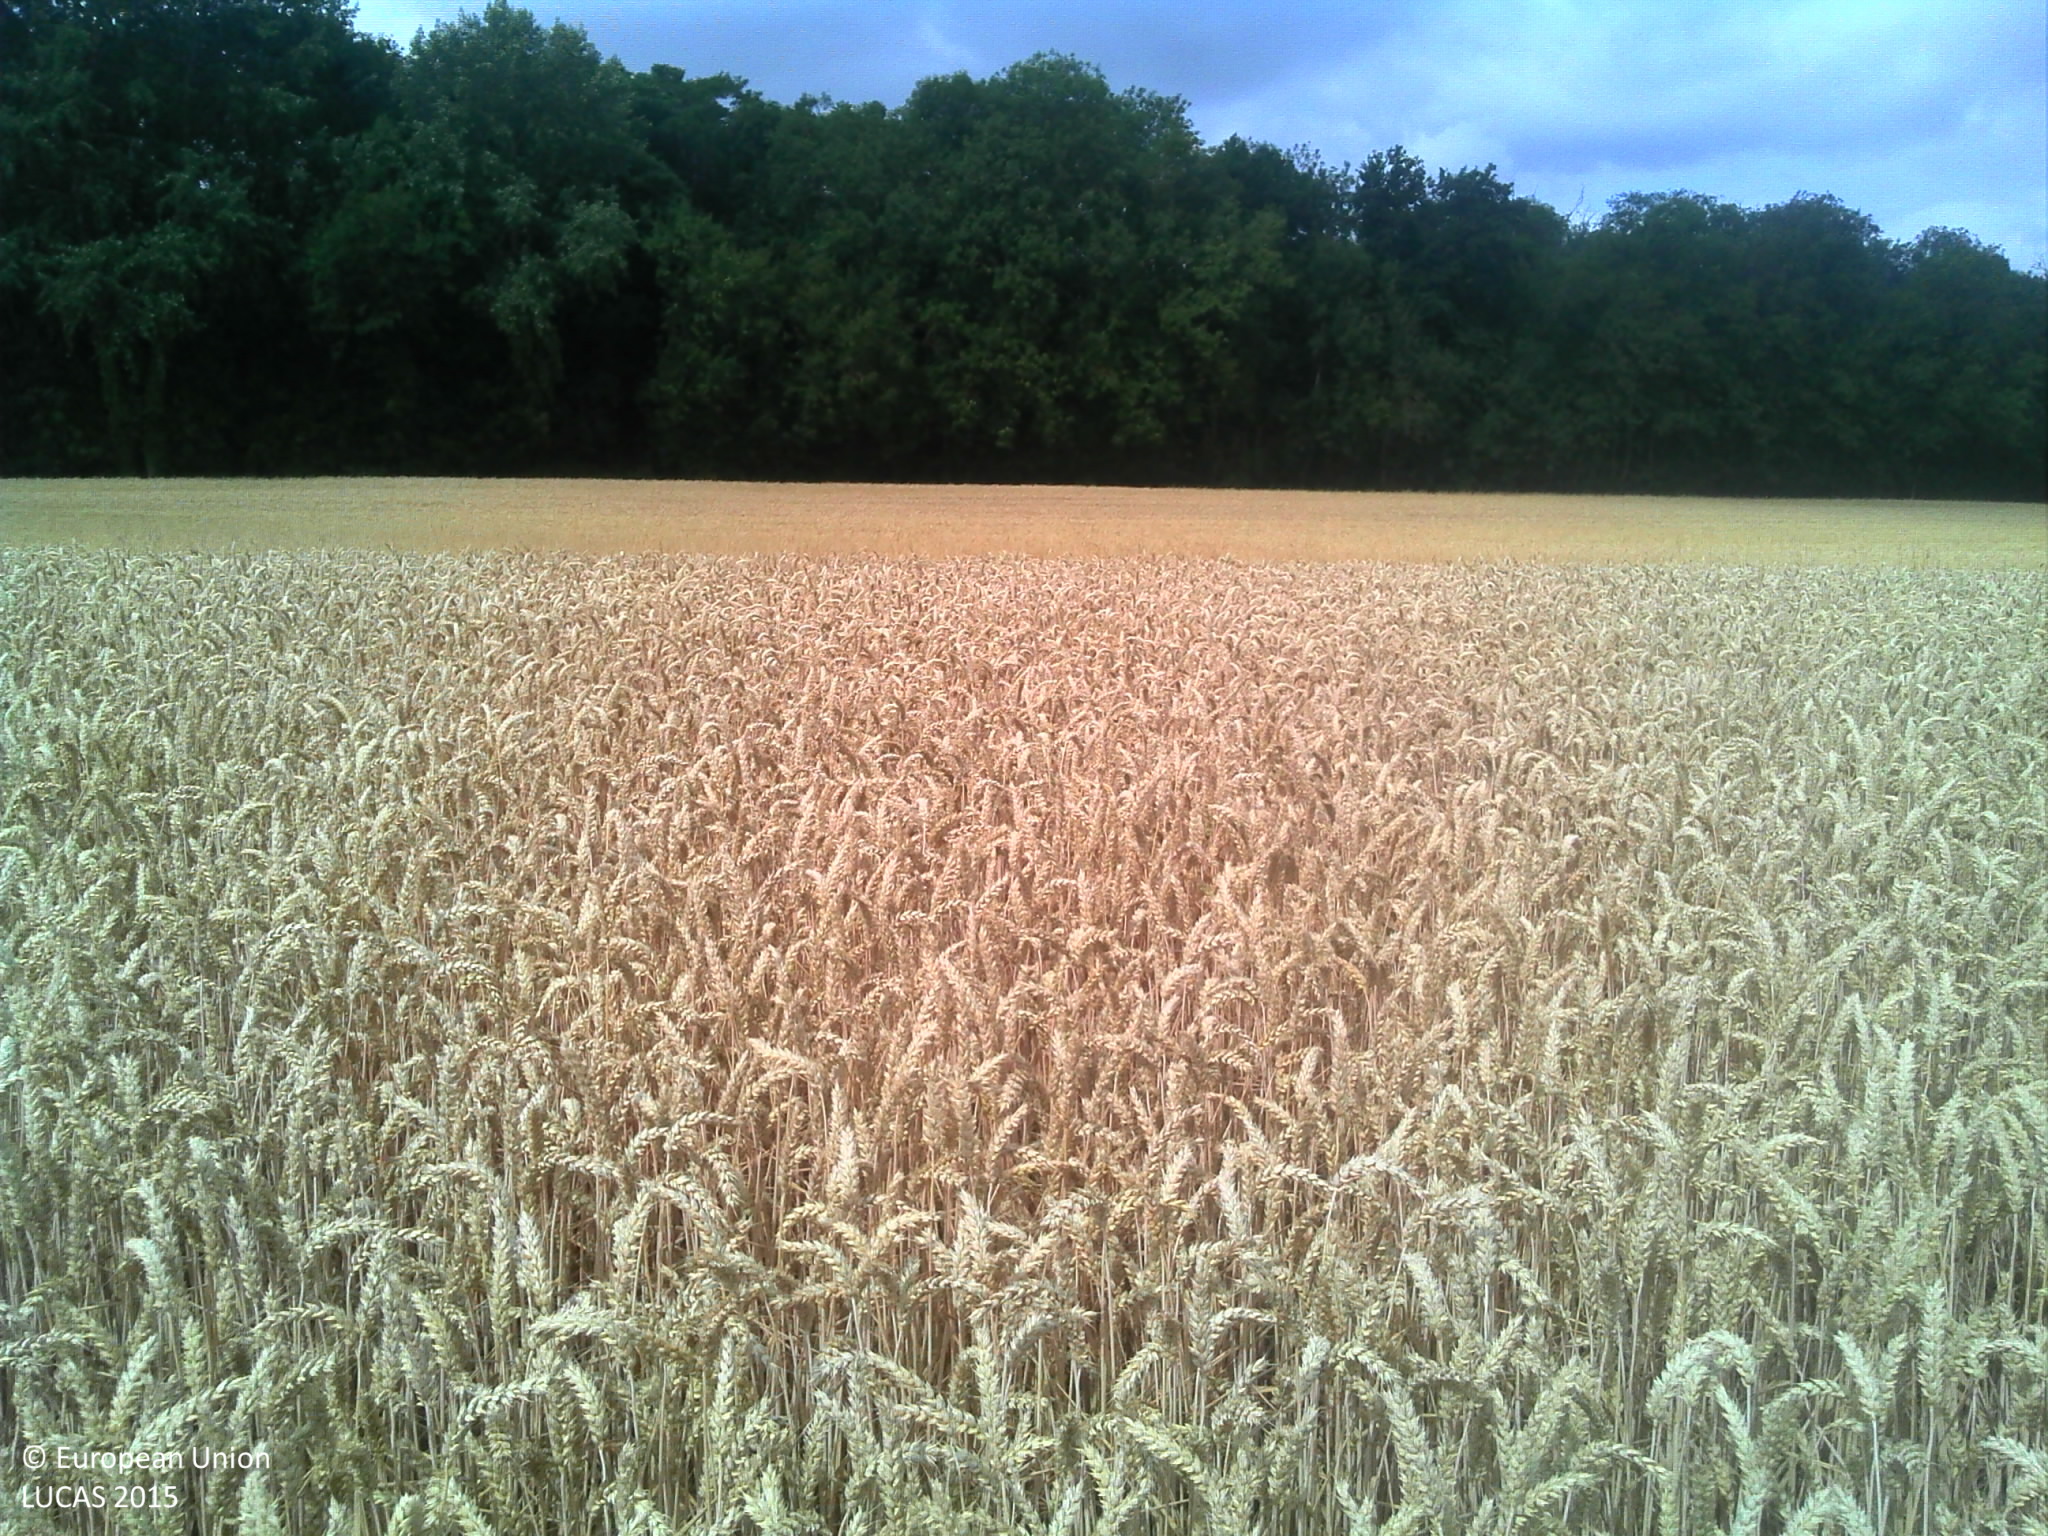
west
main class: Cropland
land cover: Common wheat
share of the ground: > 75 %
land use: Agriculture (excluding fallow land and kitchen gardens)
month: July
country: FR
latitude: 49.2636
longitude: 3.2724
